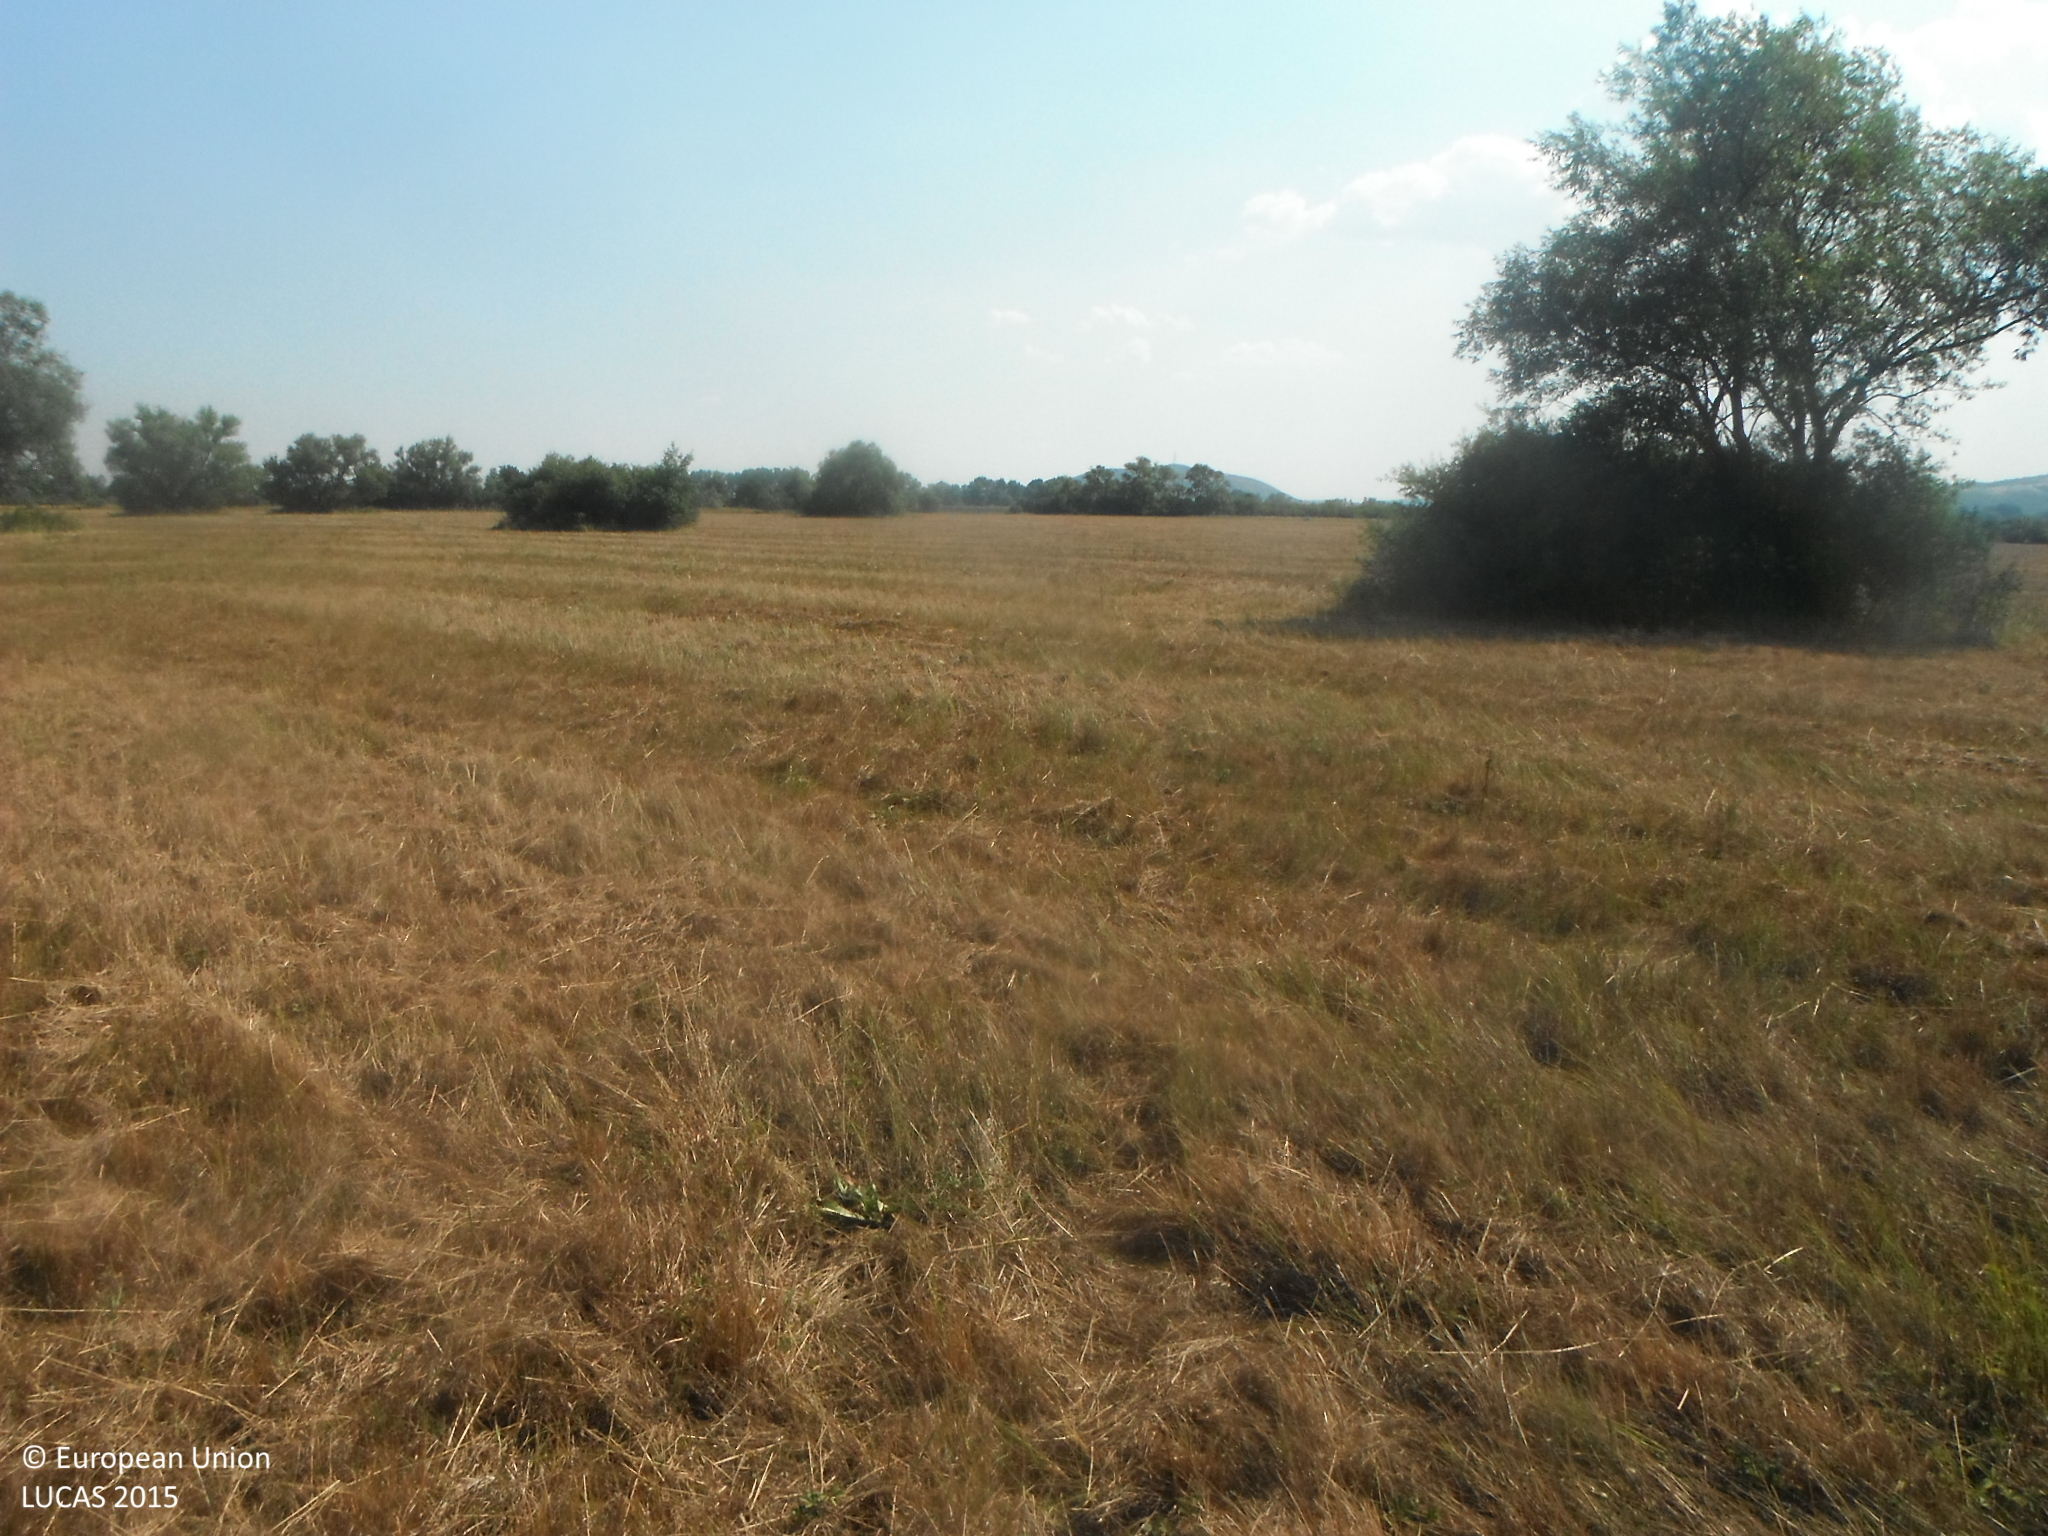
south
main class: Grassland
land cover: Grassland without tree/shrub cover
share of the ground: > 75 %
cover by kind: herbaceous plants 100 %
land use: Agriculture (excluding fallow land and kitchen gardens)
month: August
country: SK
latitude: 48.5484
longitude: 21.8237
